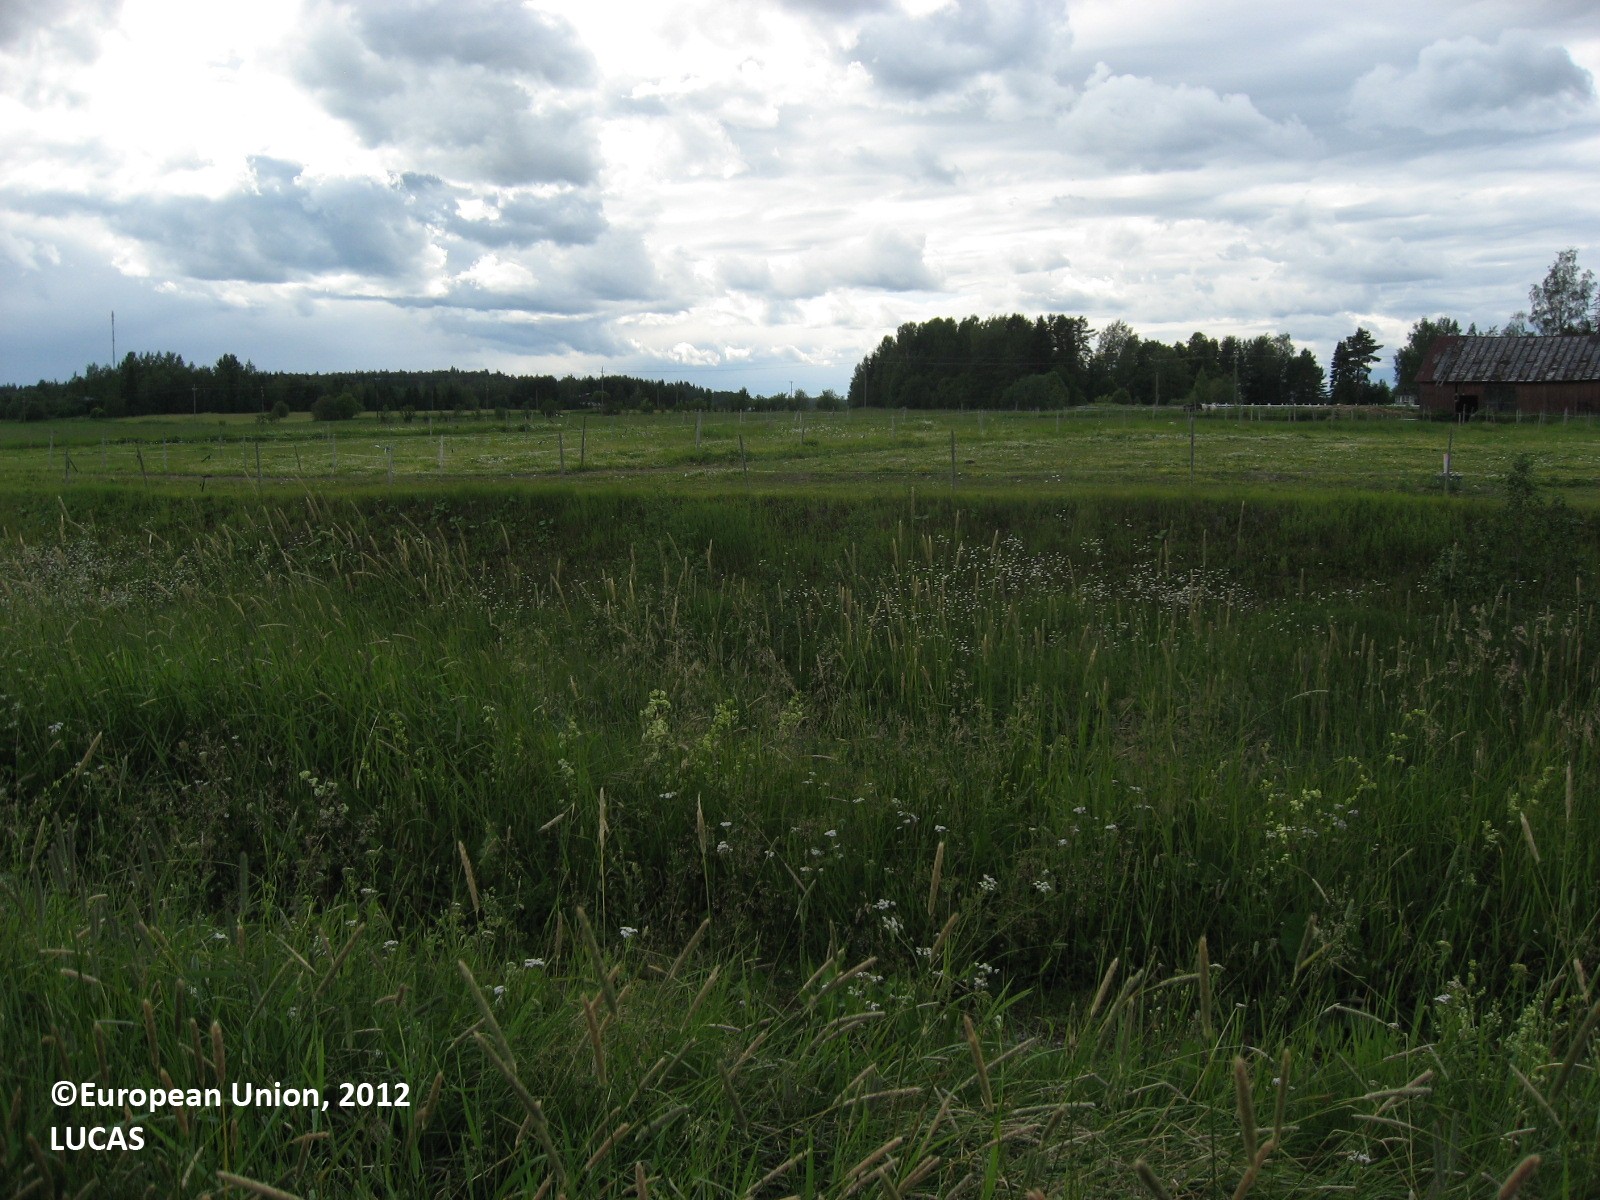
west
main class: Cropland
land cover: Common wheat
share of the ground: > 75 %
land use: Agriculture (excluding fallow land and kitchen gardens)
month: June
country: FI
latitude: 60.7358
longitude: 26.4560
